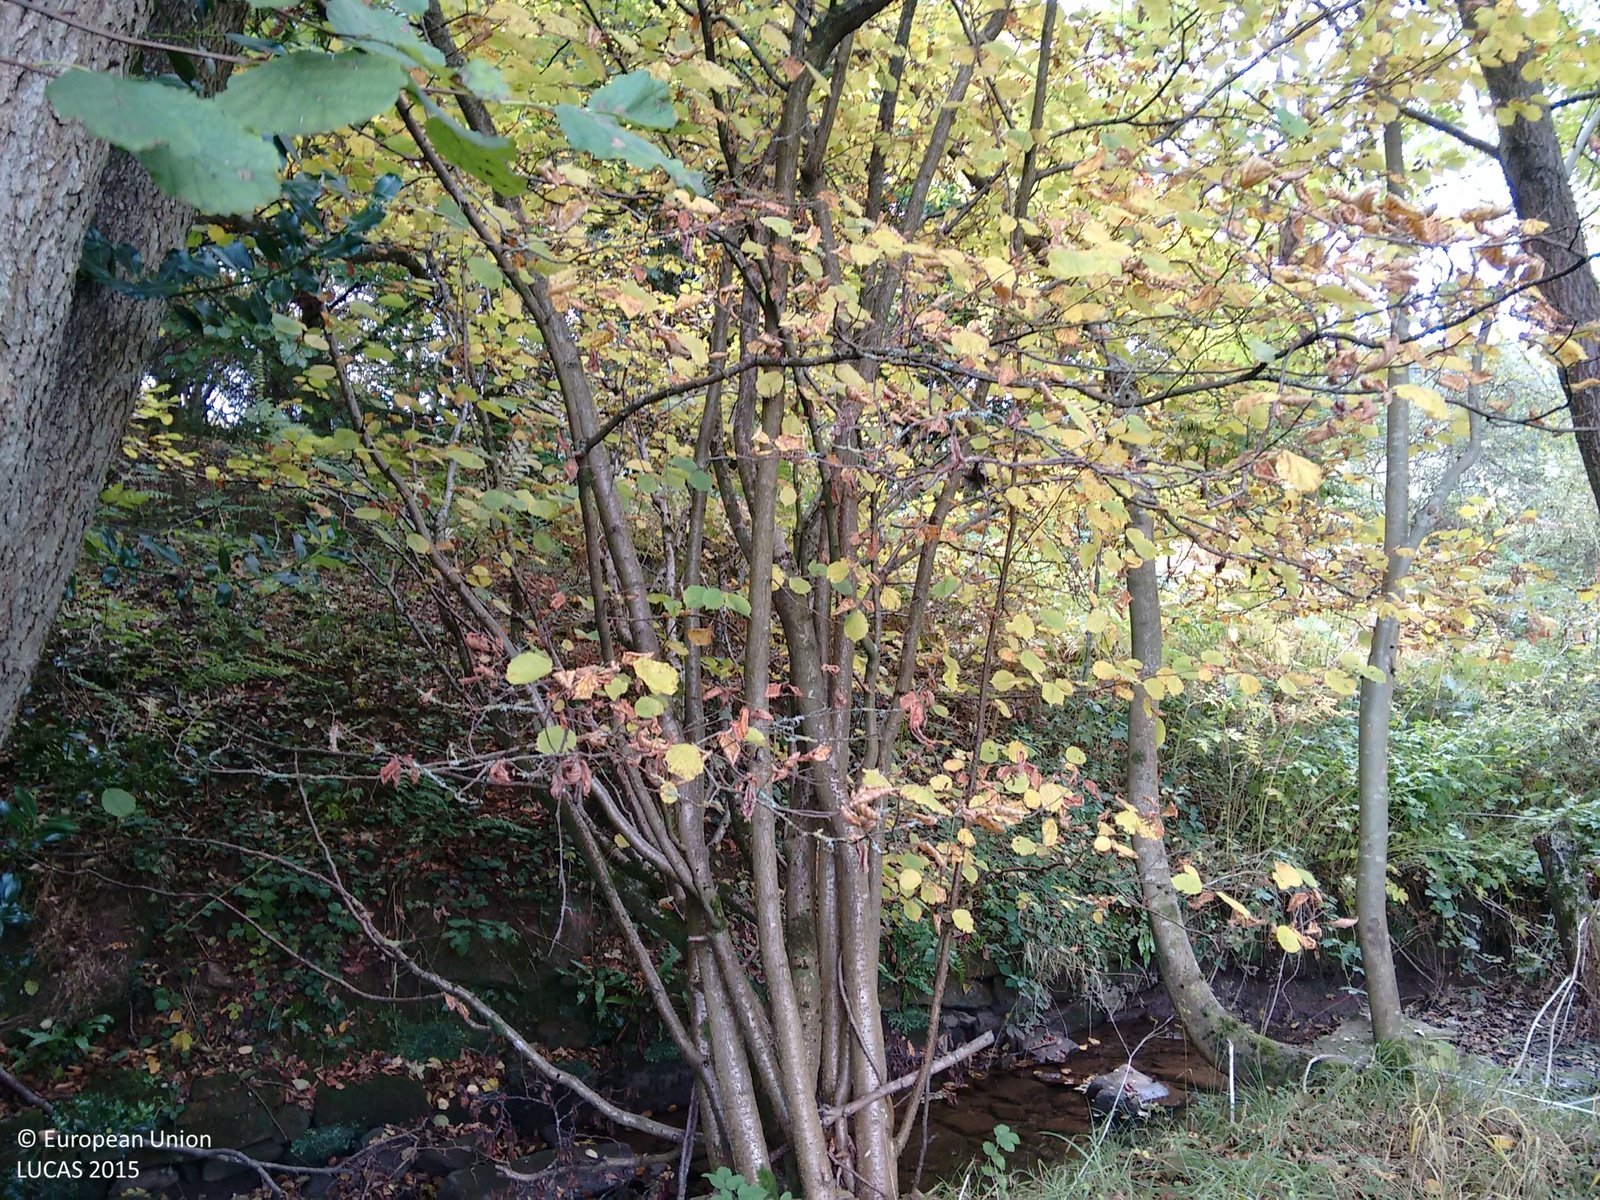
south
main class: Woodland
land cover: Broadleaved woodland
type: mesophytic deciduous forest
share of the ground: > 75 %
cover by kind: broadleaved forest trees 80 %, shrubs 10 %, herbaceous plants 10 %
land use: Semi-natural and natural areas not in use
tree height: > 5 m
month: October
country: GB
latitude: 51.7688
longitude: -2.6620
